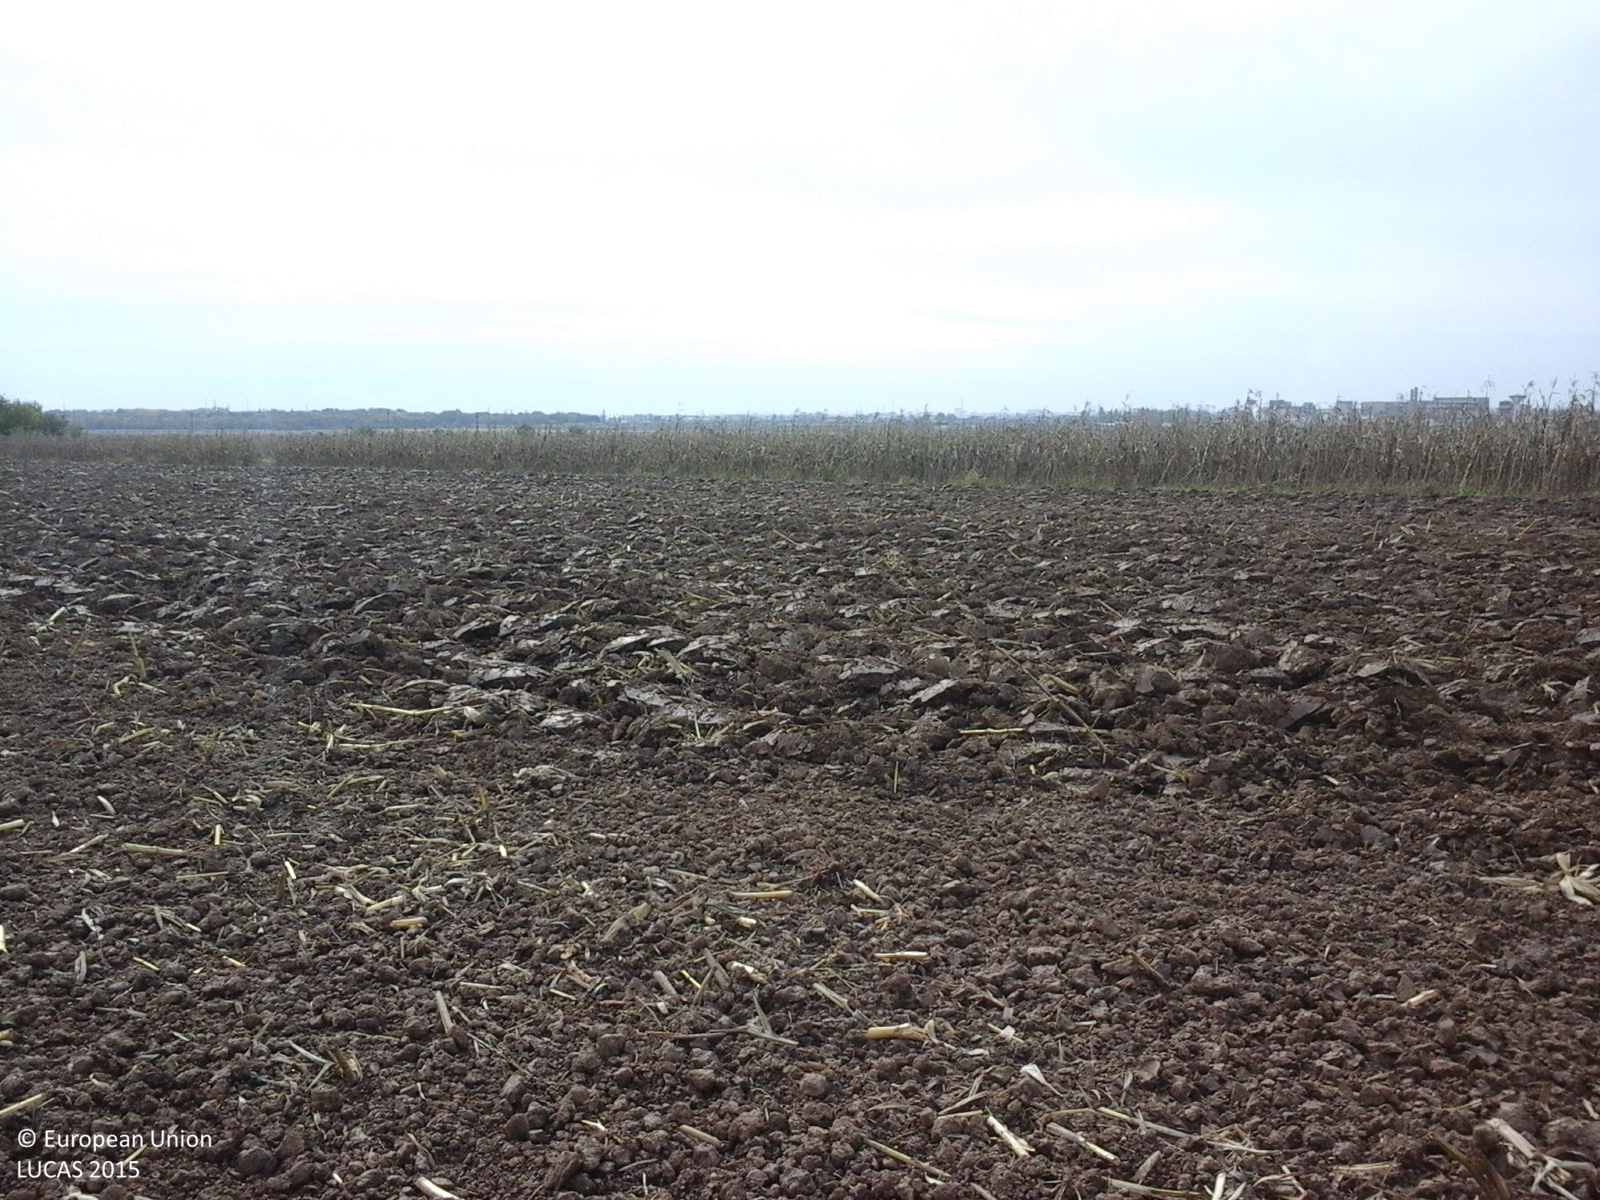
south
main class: Cropland
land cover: Maize
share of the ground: < 10 %
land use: Agriculture (excluding fallow land and kitchen gardens)
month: October
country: RO
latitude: 44.9998
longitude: 26.0556
